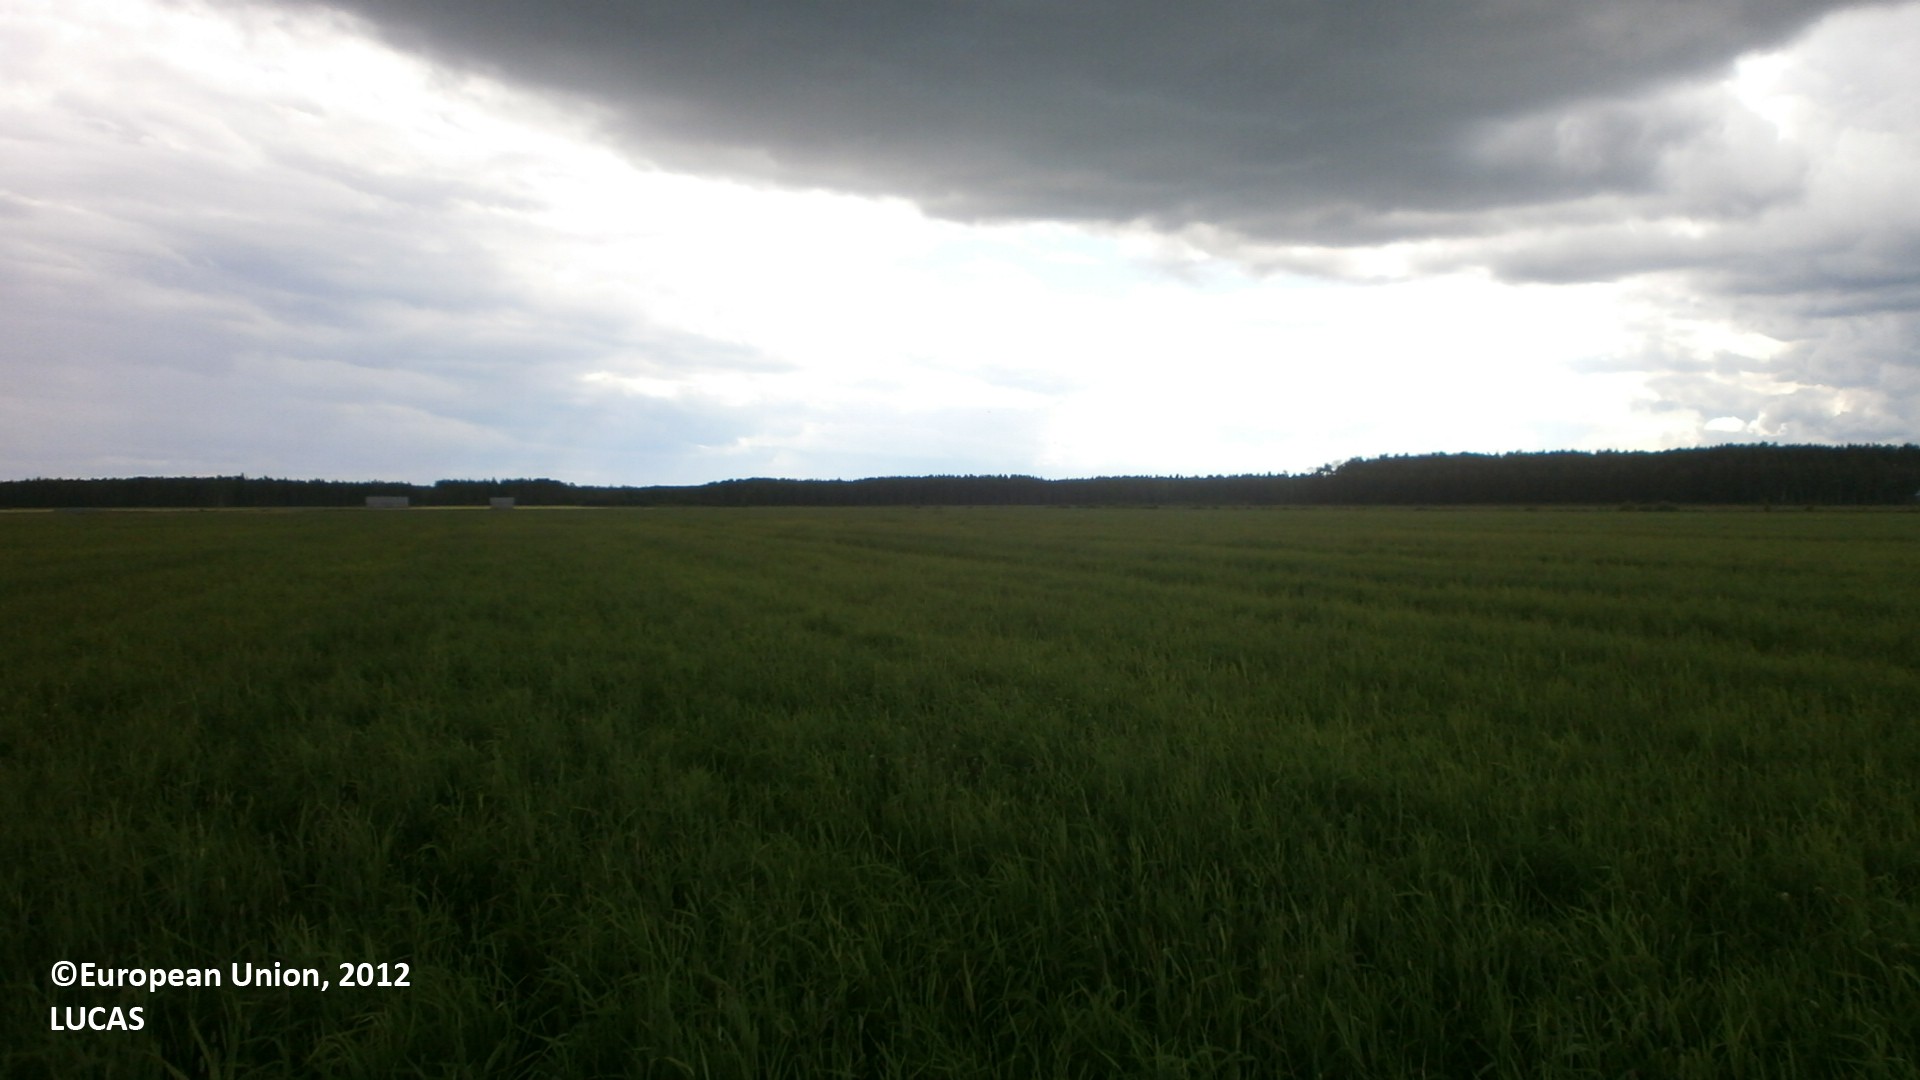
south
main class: Cropland
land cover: Temporary grasslands
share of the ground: > 75 %
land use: Agriculture (excluding fallow land and kitchen gardens)
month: July
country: FI
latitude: 64.1785
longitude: 24.2036
